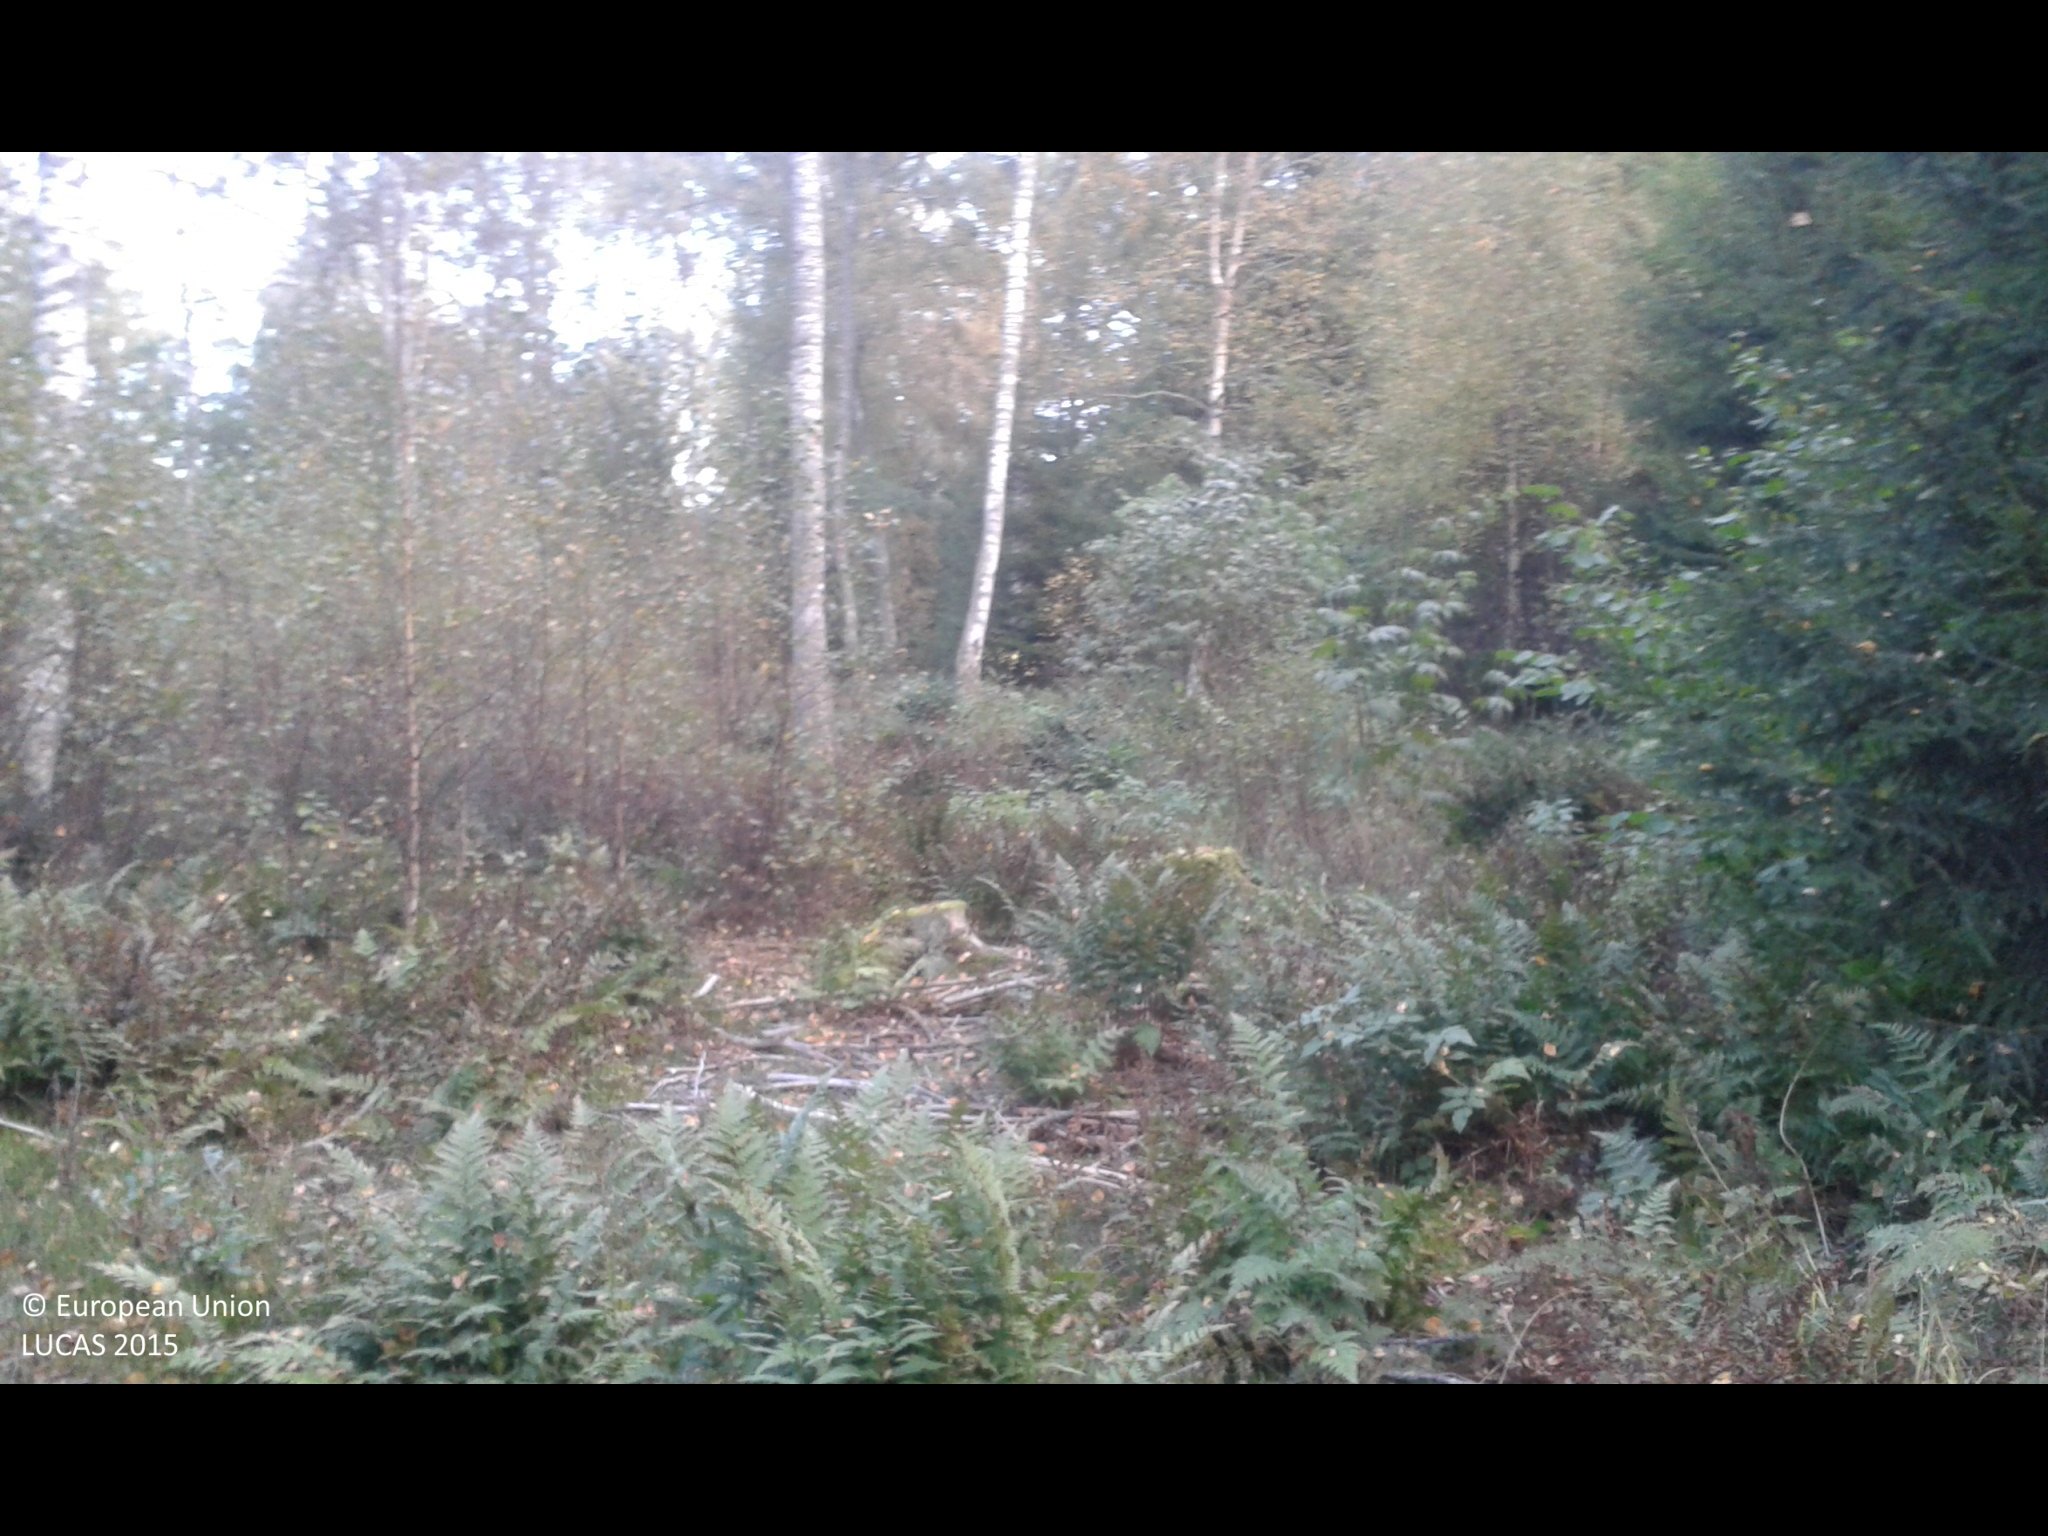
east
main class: Woodland
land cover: Spruce dominated mixed woodland
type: hemiboreal forest and nemoral coniferous forest and mixed broadleaved-coniferous forest
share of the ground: 50 - 75 %
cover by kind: broadleaved forest trees 45 %, herbaceous plants 40 %, coniferous forest trees 15 %
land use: Forestry
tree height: > 5 m
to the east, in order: Spruce dominated mixed woodland; Ditches and canals; Spruce dominated mixed woodland
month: September
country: SE
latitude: 58.9346
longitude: 17.4513
